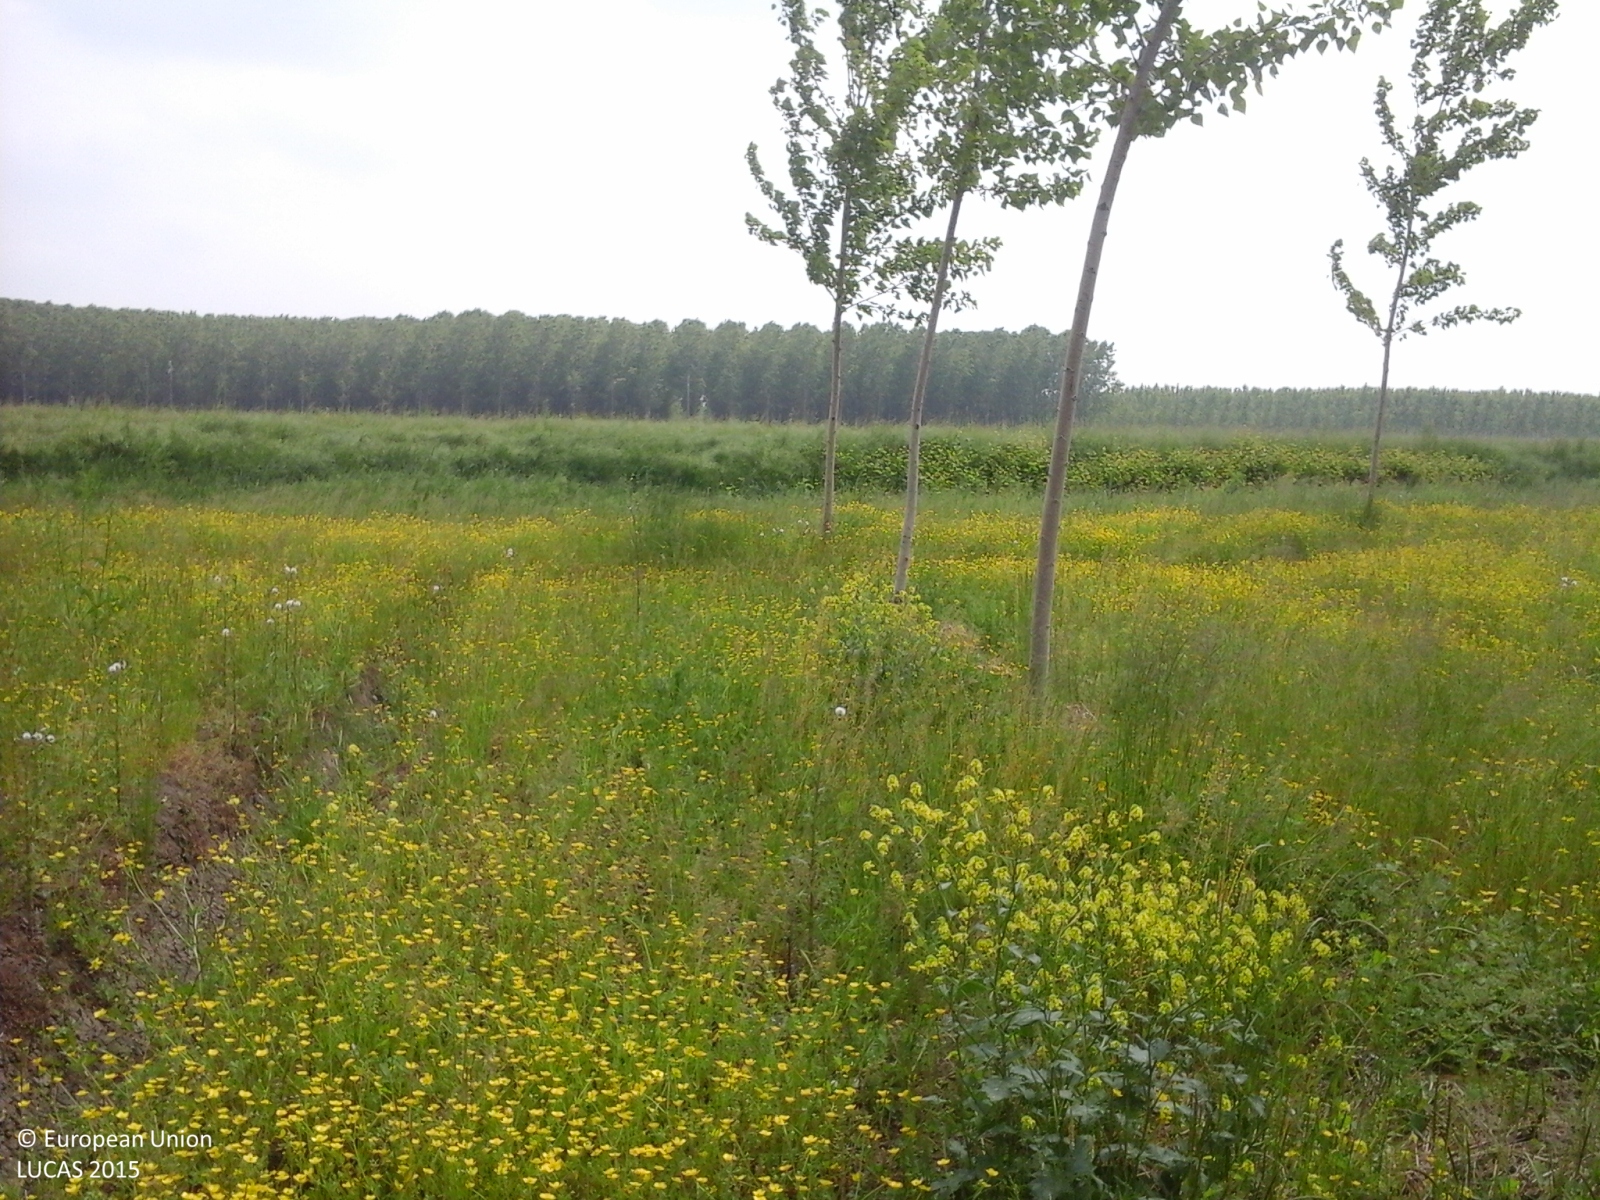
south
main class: Woodland
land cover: Broadleaved woodland
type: non-riverine alder, birch or aspen forest
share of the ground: 10 - 25 %
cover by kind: herbaceous plants 80 %, broadleaved forest trees 20 %
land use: Forestry
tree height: > 5 m
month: May
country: IT
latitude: 44.8892
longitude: 10.6950
